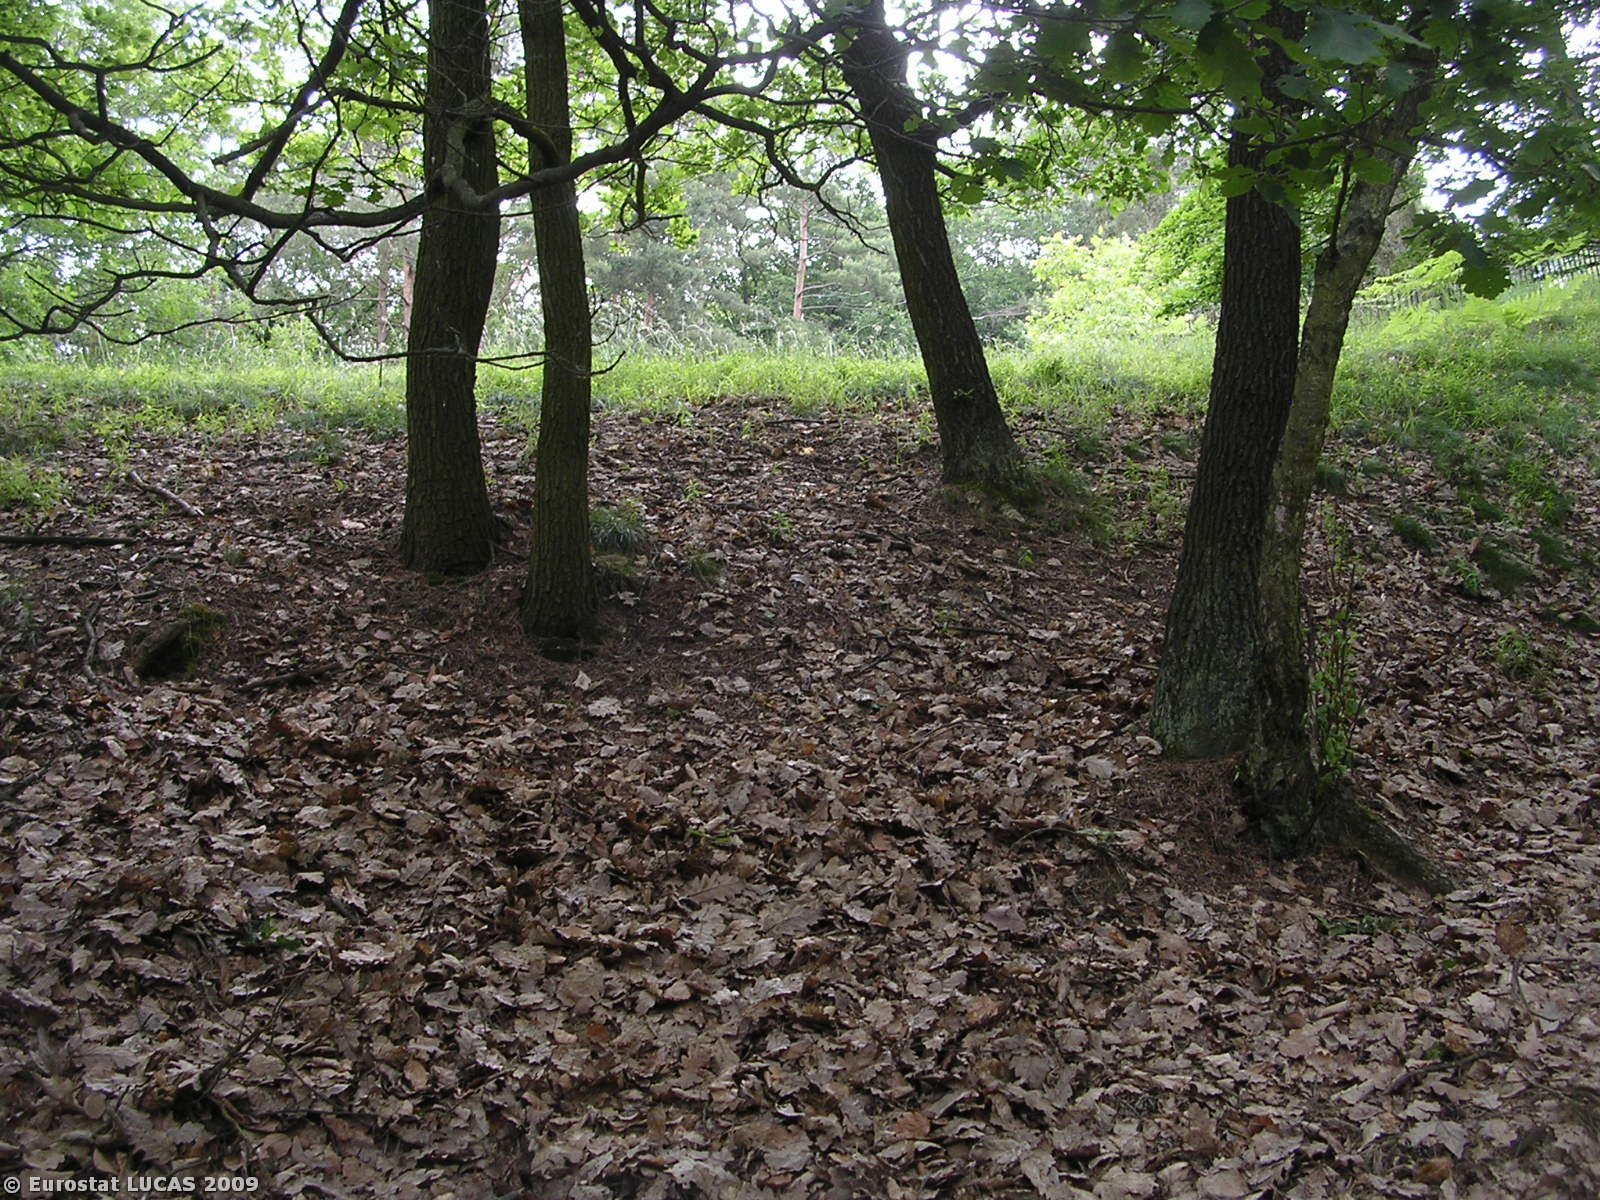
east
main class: Woodland
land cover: Mixed woodland
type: hemiboreal forest and nemoral coniferous forest and mixed broadleaved-coniferous forest
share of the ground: > 75 %
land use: Forestry
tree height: > 5 m
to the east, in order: Mixed woodland; Grassland with sparse tree/shrub cover; Mixed woodland; Rock outcrops; Mixed woodland; Grassland with sparse tree/shrub cover; Grassland without tree/shrub cover; Tracks; Grassland without tree/shrub cover
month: June
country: CZ
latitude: 50.5086
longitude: 14.5282
